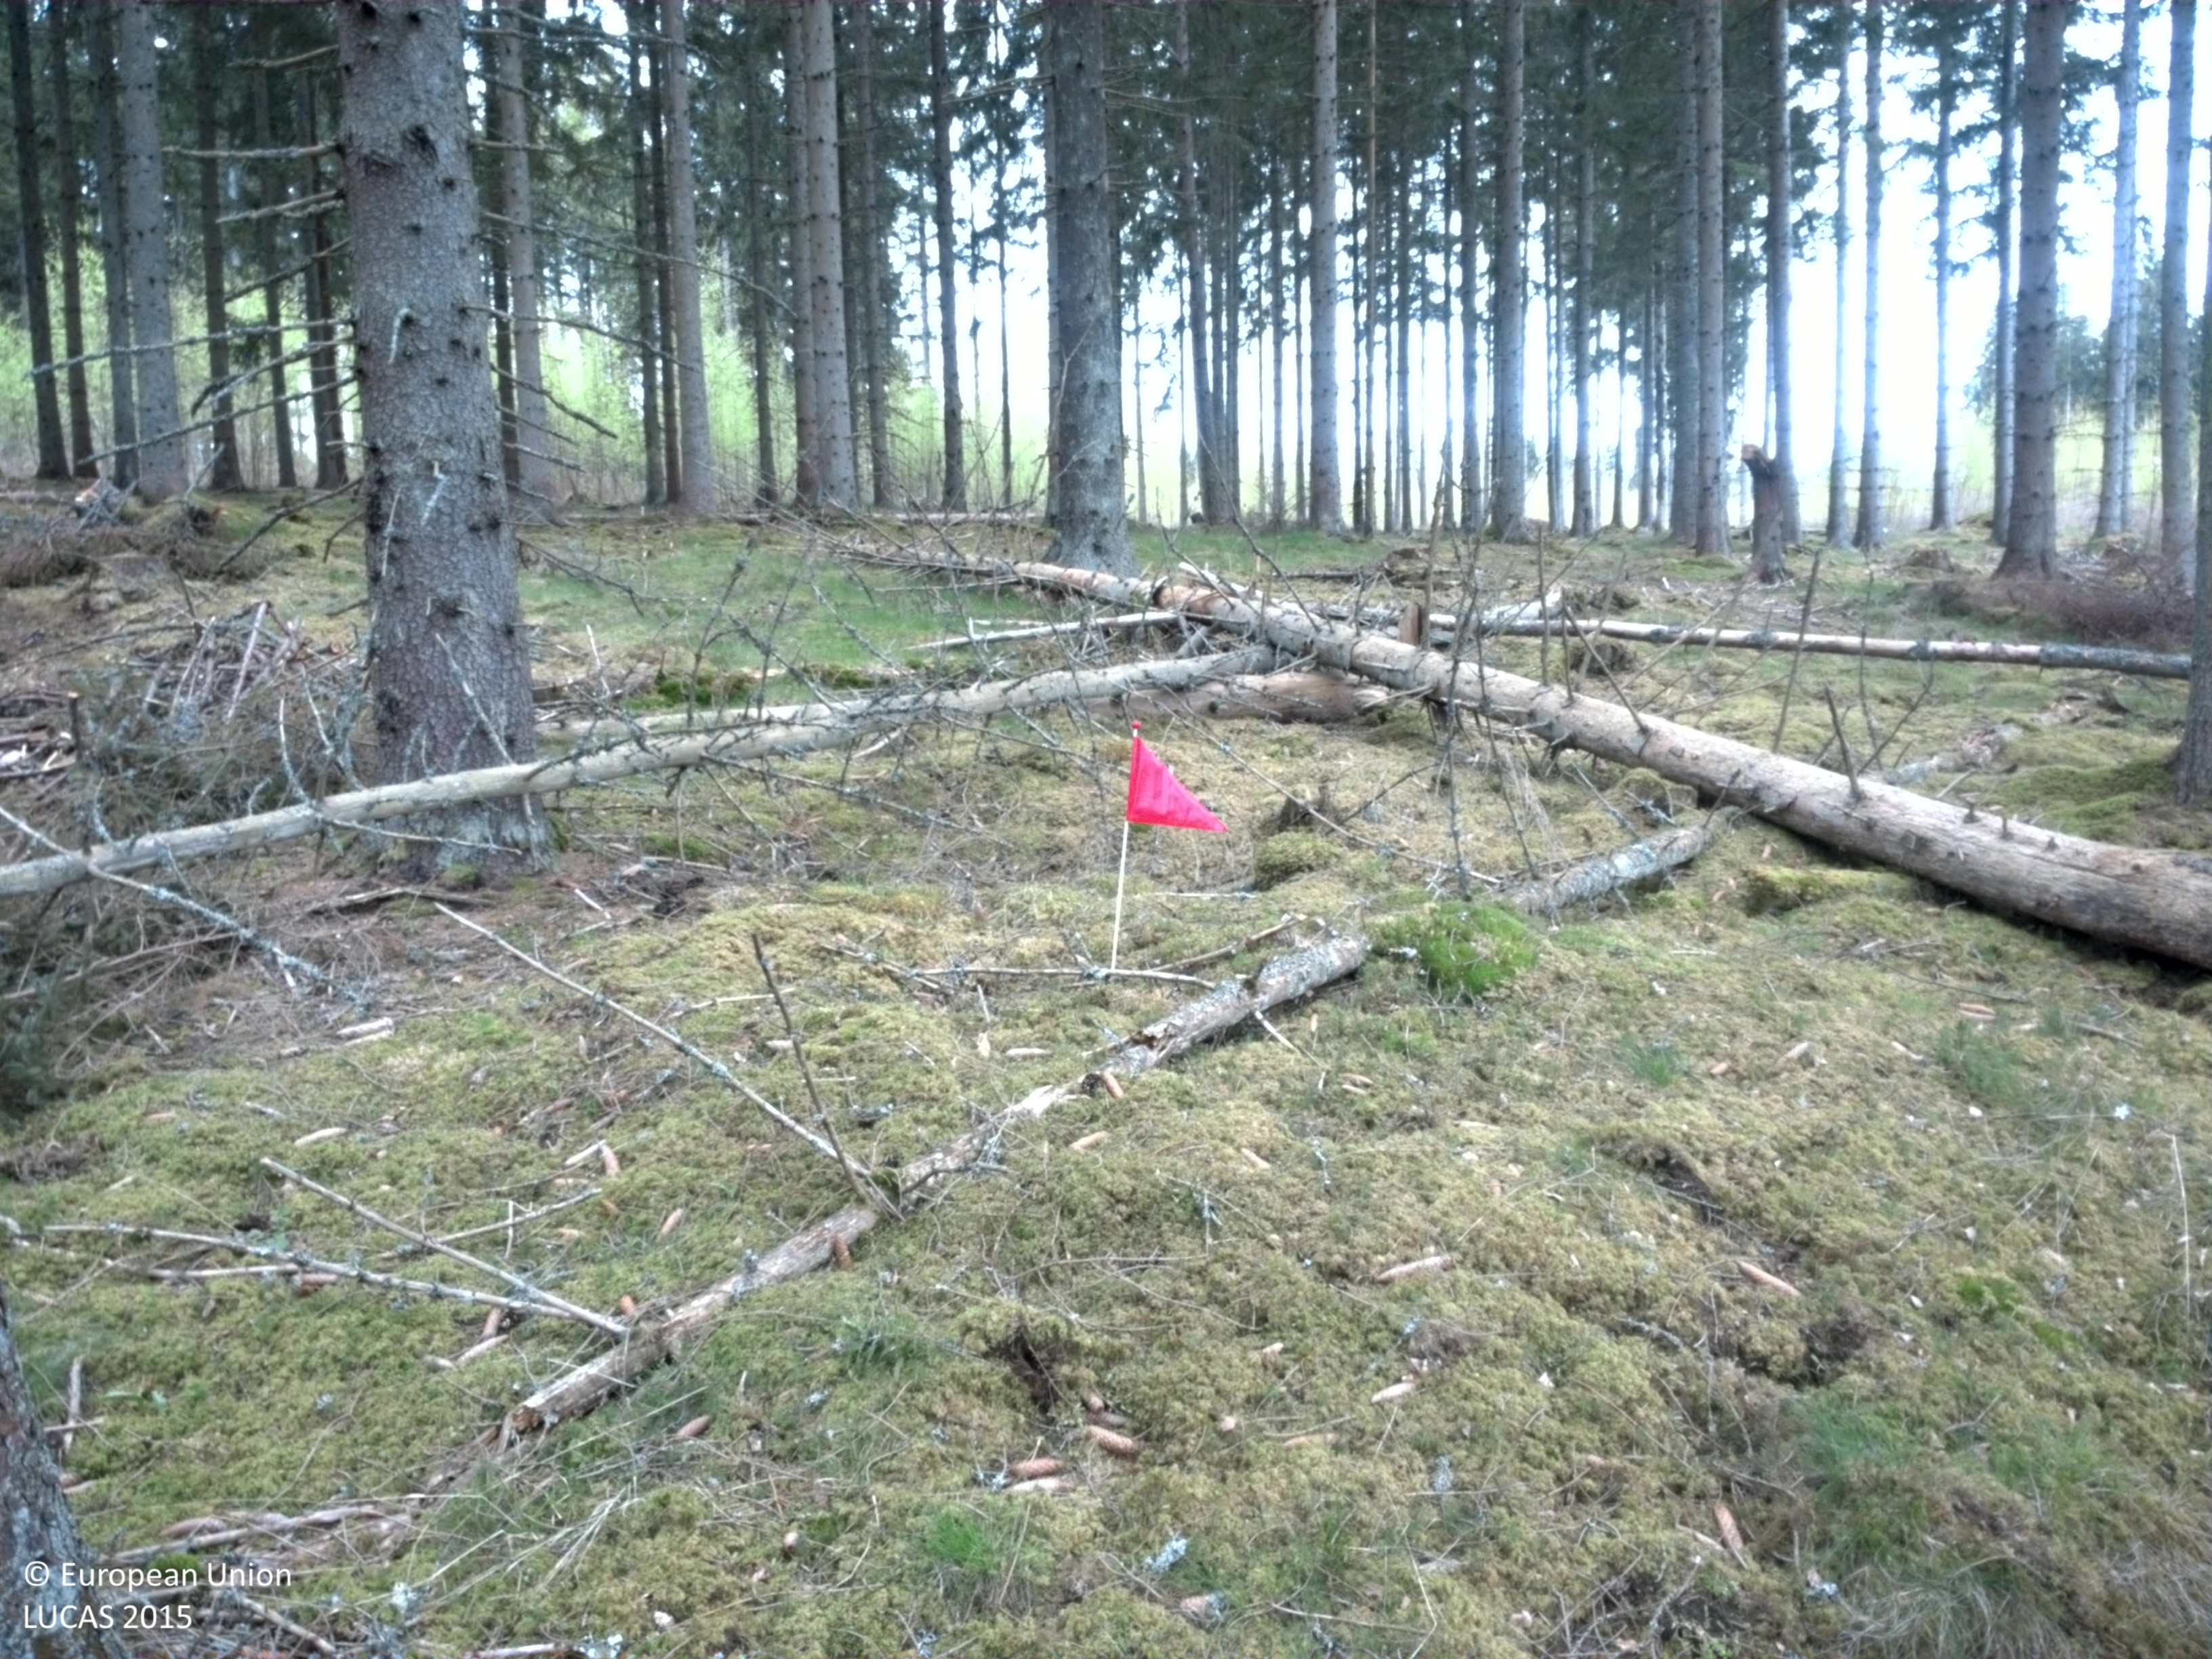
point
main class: Woodland
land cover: Spruce dominated coniferous woodland
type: boreal forest
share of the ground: > 75 %
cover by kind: coniferous forest trees 80 %, lichens and mosses 20 %
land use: Forestry
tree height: > 5 m
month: May
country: SE
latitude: 56.8378
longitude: 14.7671
